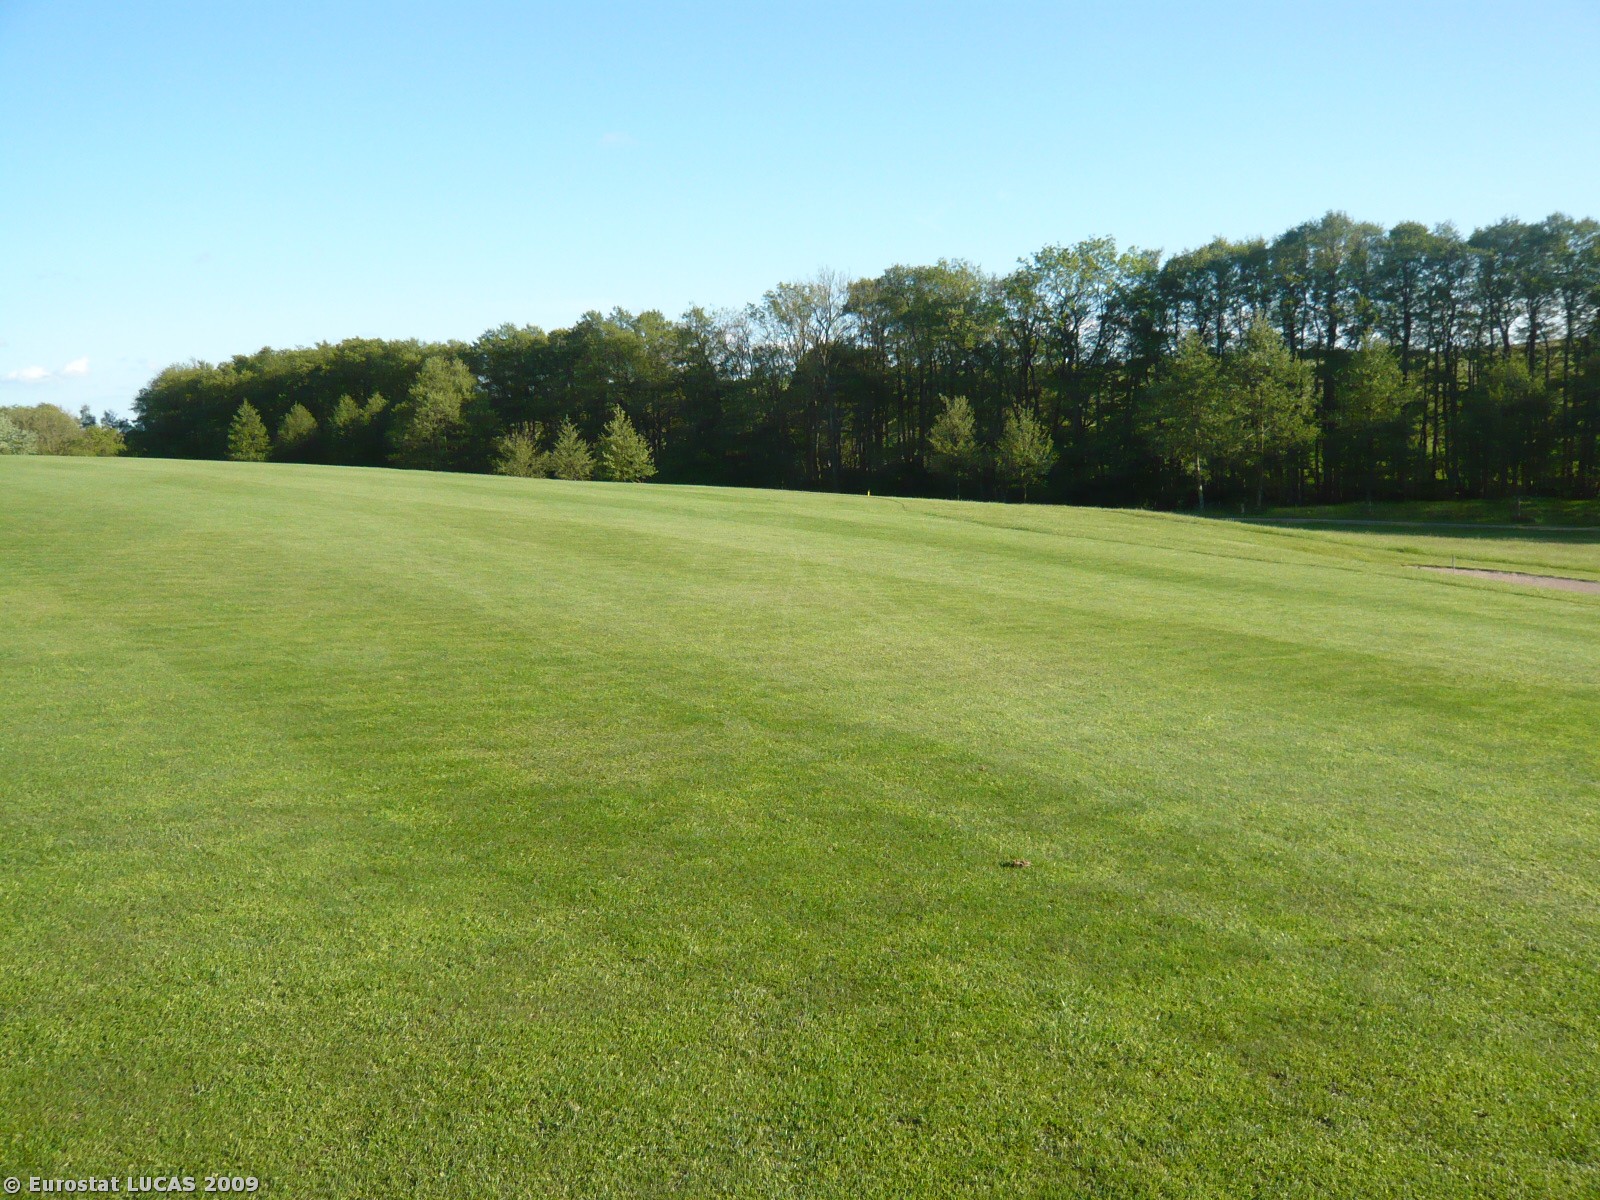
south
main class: Grassland
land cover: Grassland without tree/shrub cover
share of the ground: > 75 %
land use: Sport
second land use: Amenities, museums, leisure
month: May
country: DK
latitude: 55.3872
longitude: 11.5615
